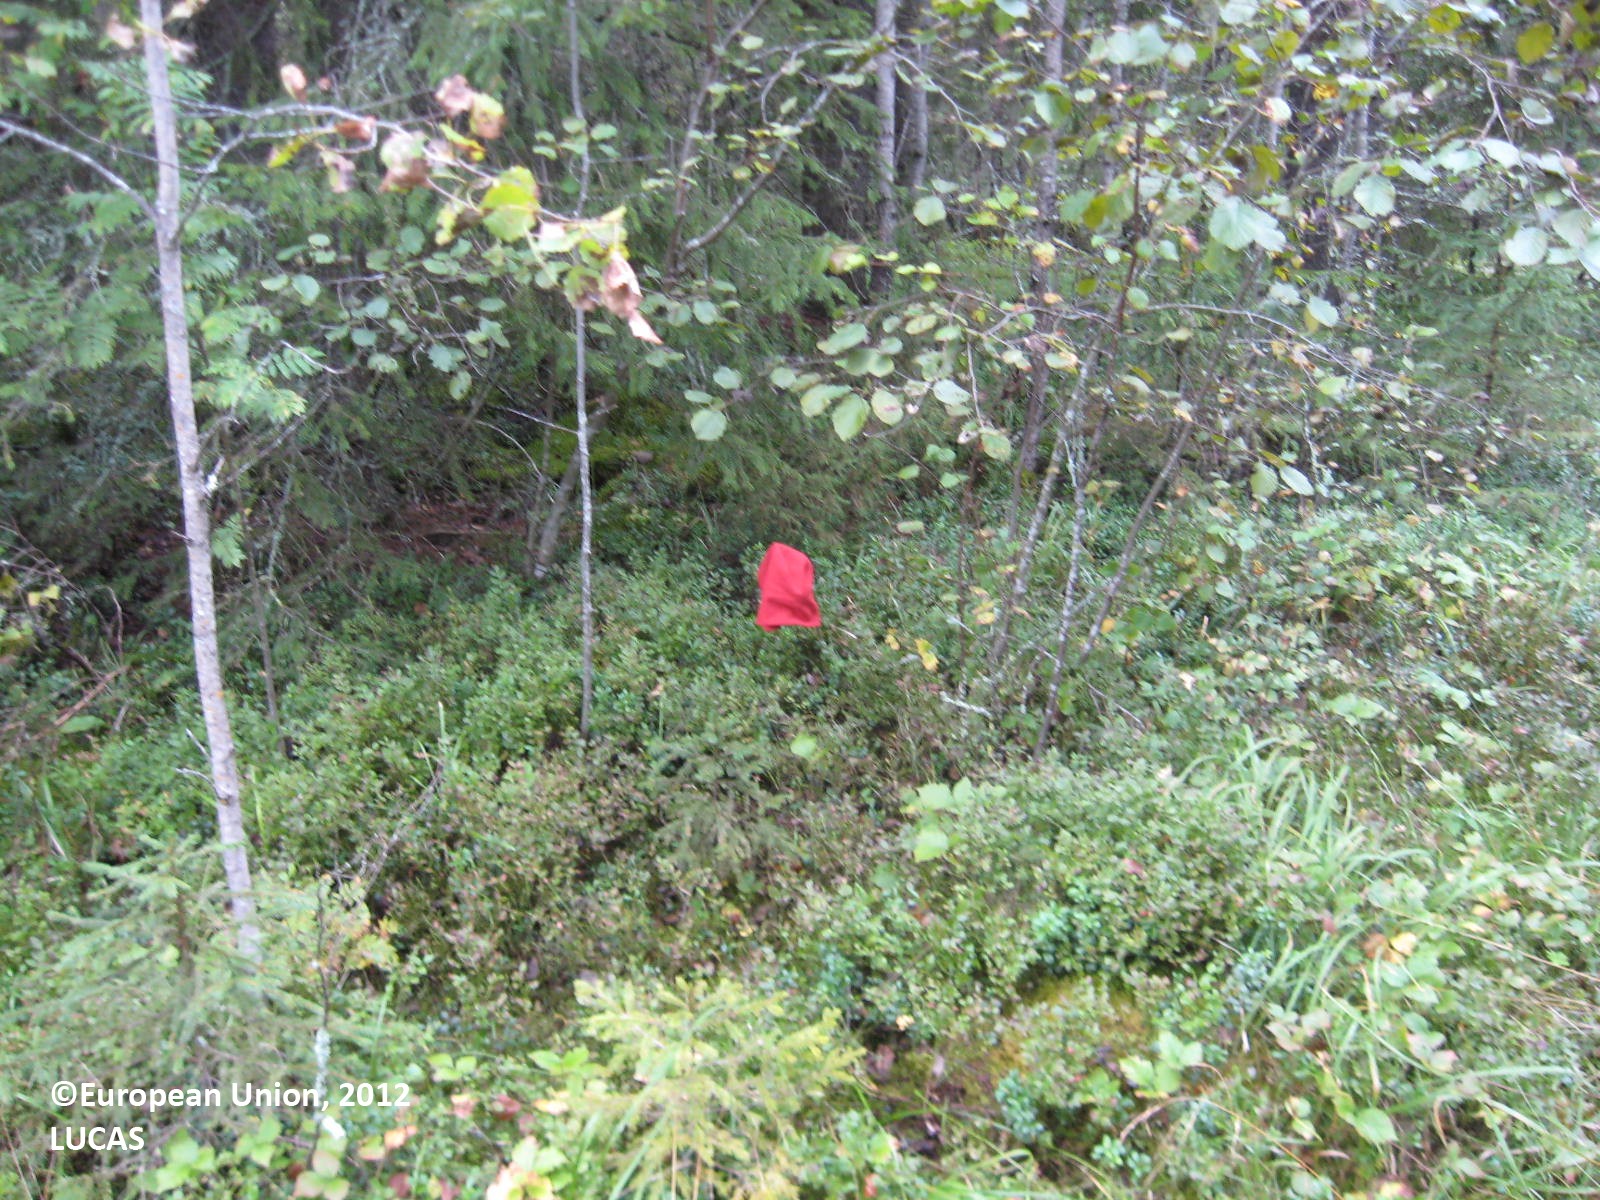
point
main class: Woodland
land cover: Spruce dominated coniferous woodland
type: boreal forest
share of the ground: > 75 %
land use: Forestry
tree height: > 5 m
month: August
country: FI
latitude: 63.6209
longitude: 29.0287
